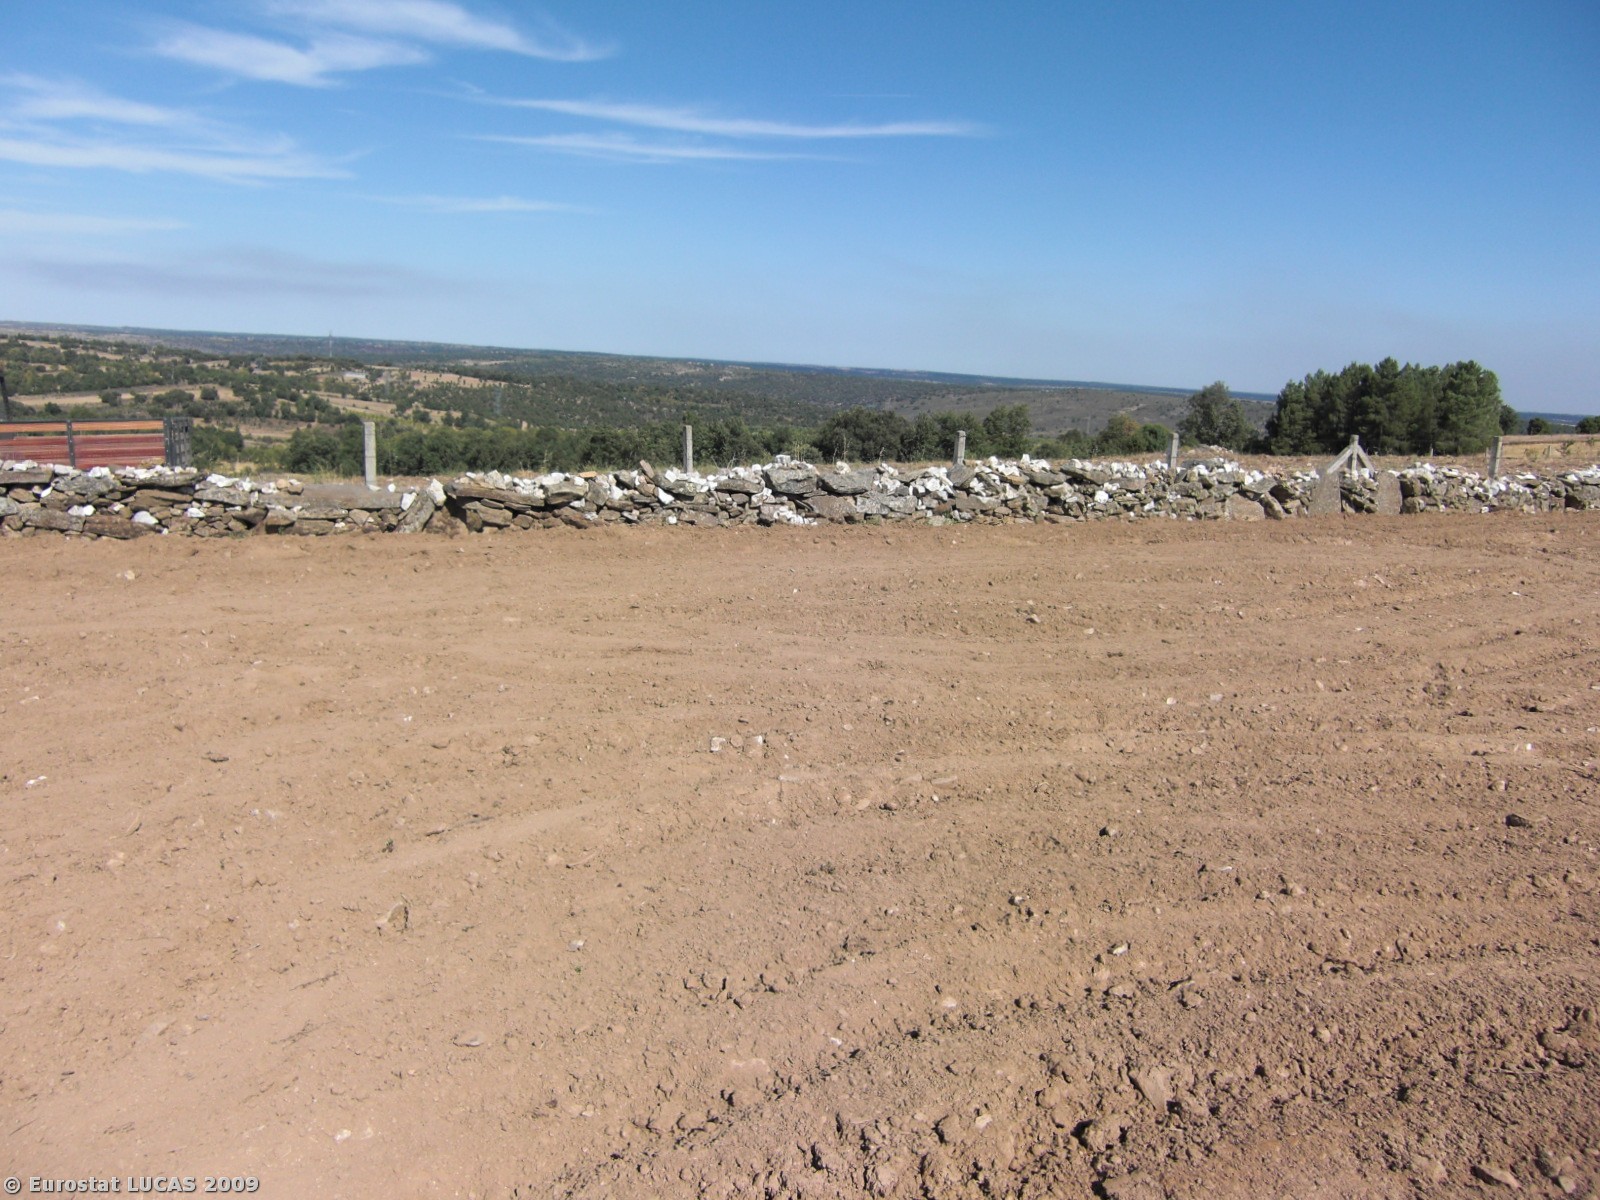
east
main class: Cropland
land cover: Other fresh vegetables
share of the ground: 10 - 25 %
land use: Agriculture (excluding fallow land and kitchen gardens)
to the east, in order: Other fresh vegetables; Bare land; Other fresh vegetables; Dry stone walls; Tracks; Fences; Spontaneously vegetated surfaces; Lines of trees; Fences; Shrubland with sparse tree cover; Lines of trees; Fences; Bare land
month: August
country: PT
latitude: 41.4667
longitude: -6.3221
